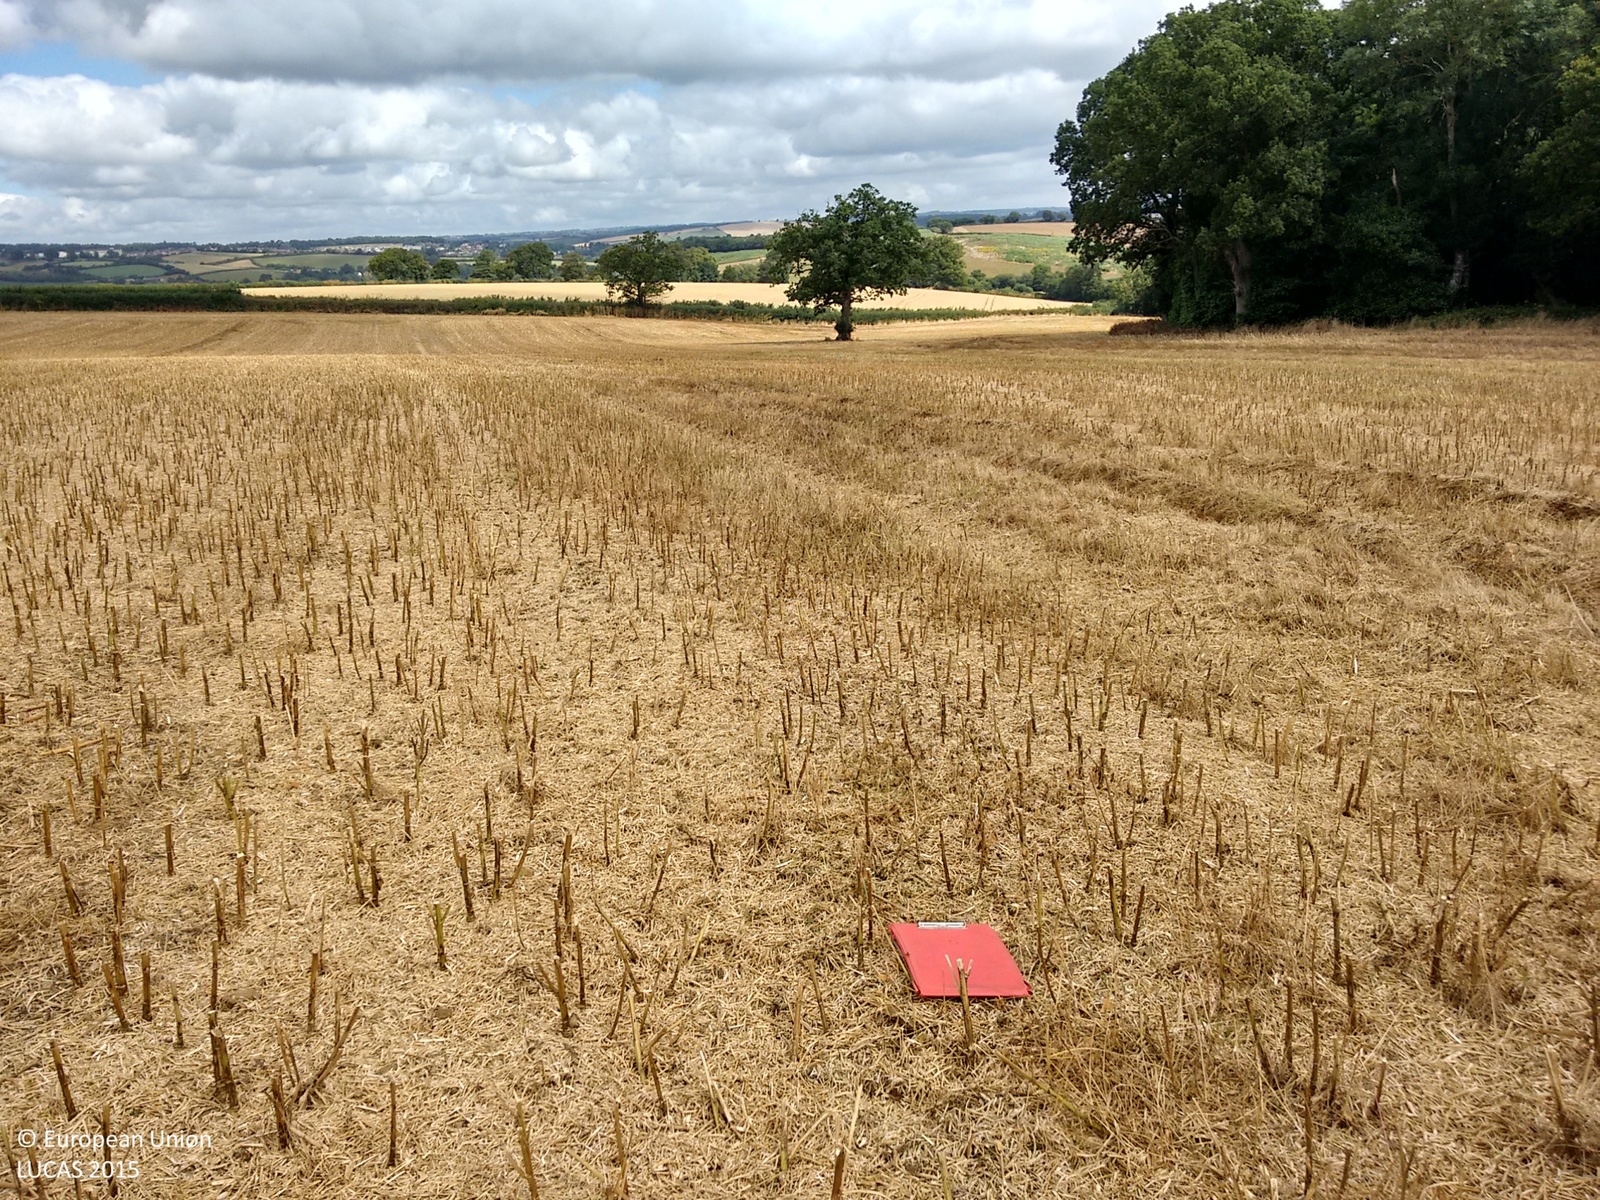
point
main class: Cropland
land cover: Rape and turnip rape
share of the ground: 10 - 25 %
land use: Agriculture (excluding fallow land and kitchen gardens)
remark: Harvested field
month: August
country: GB
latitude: 50.7625
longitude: -3.6546
